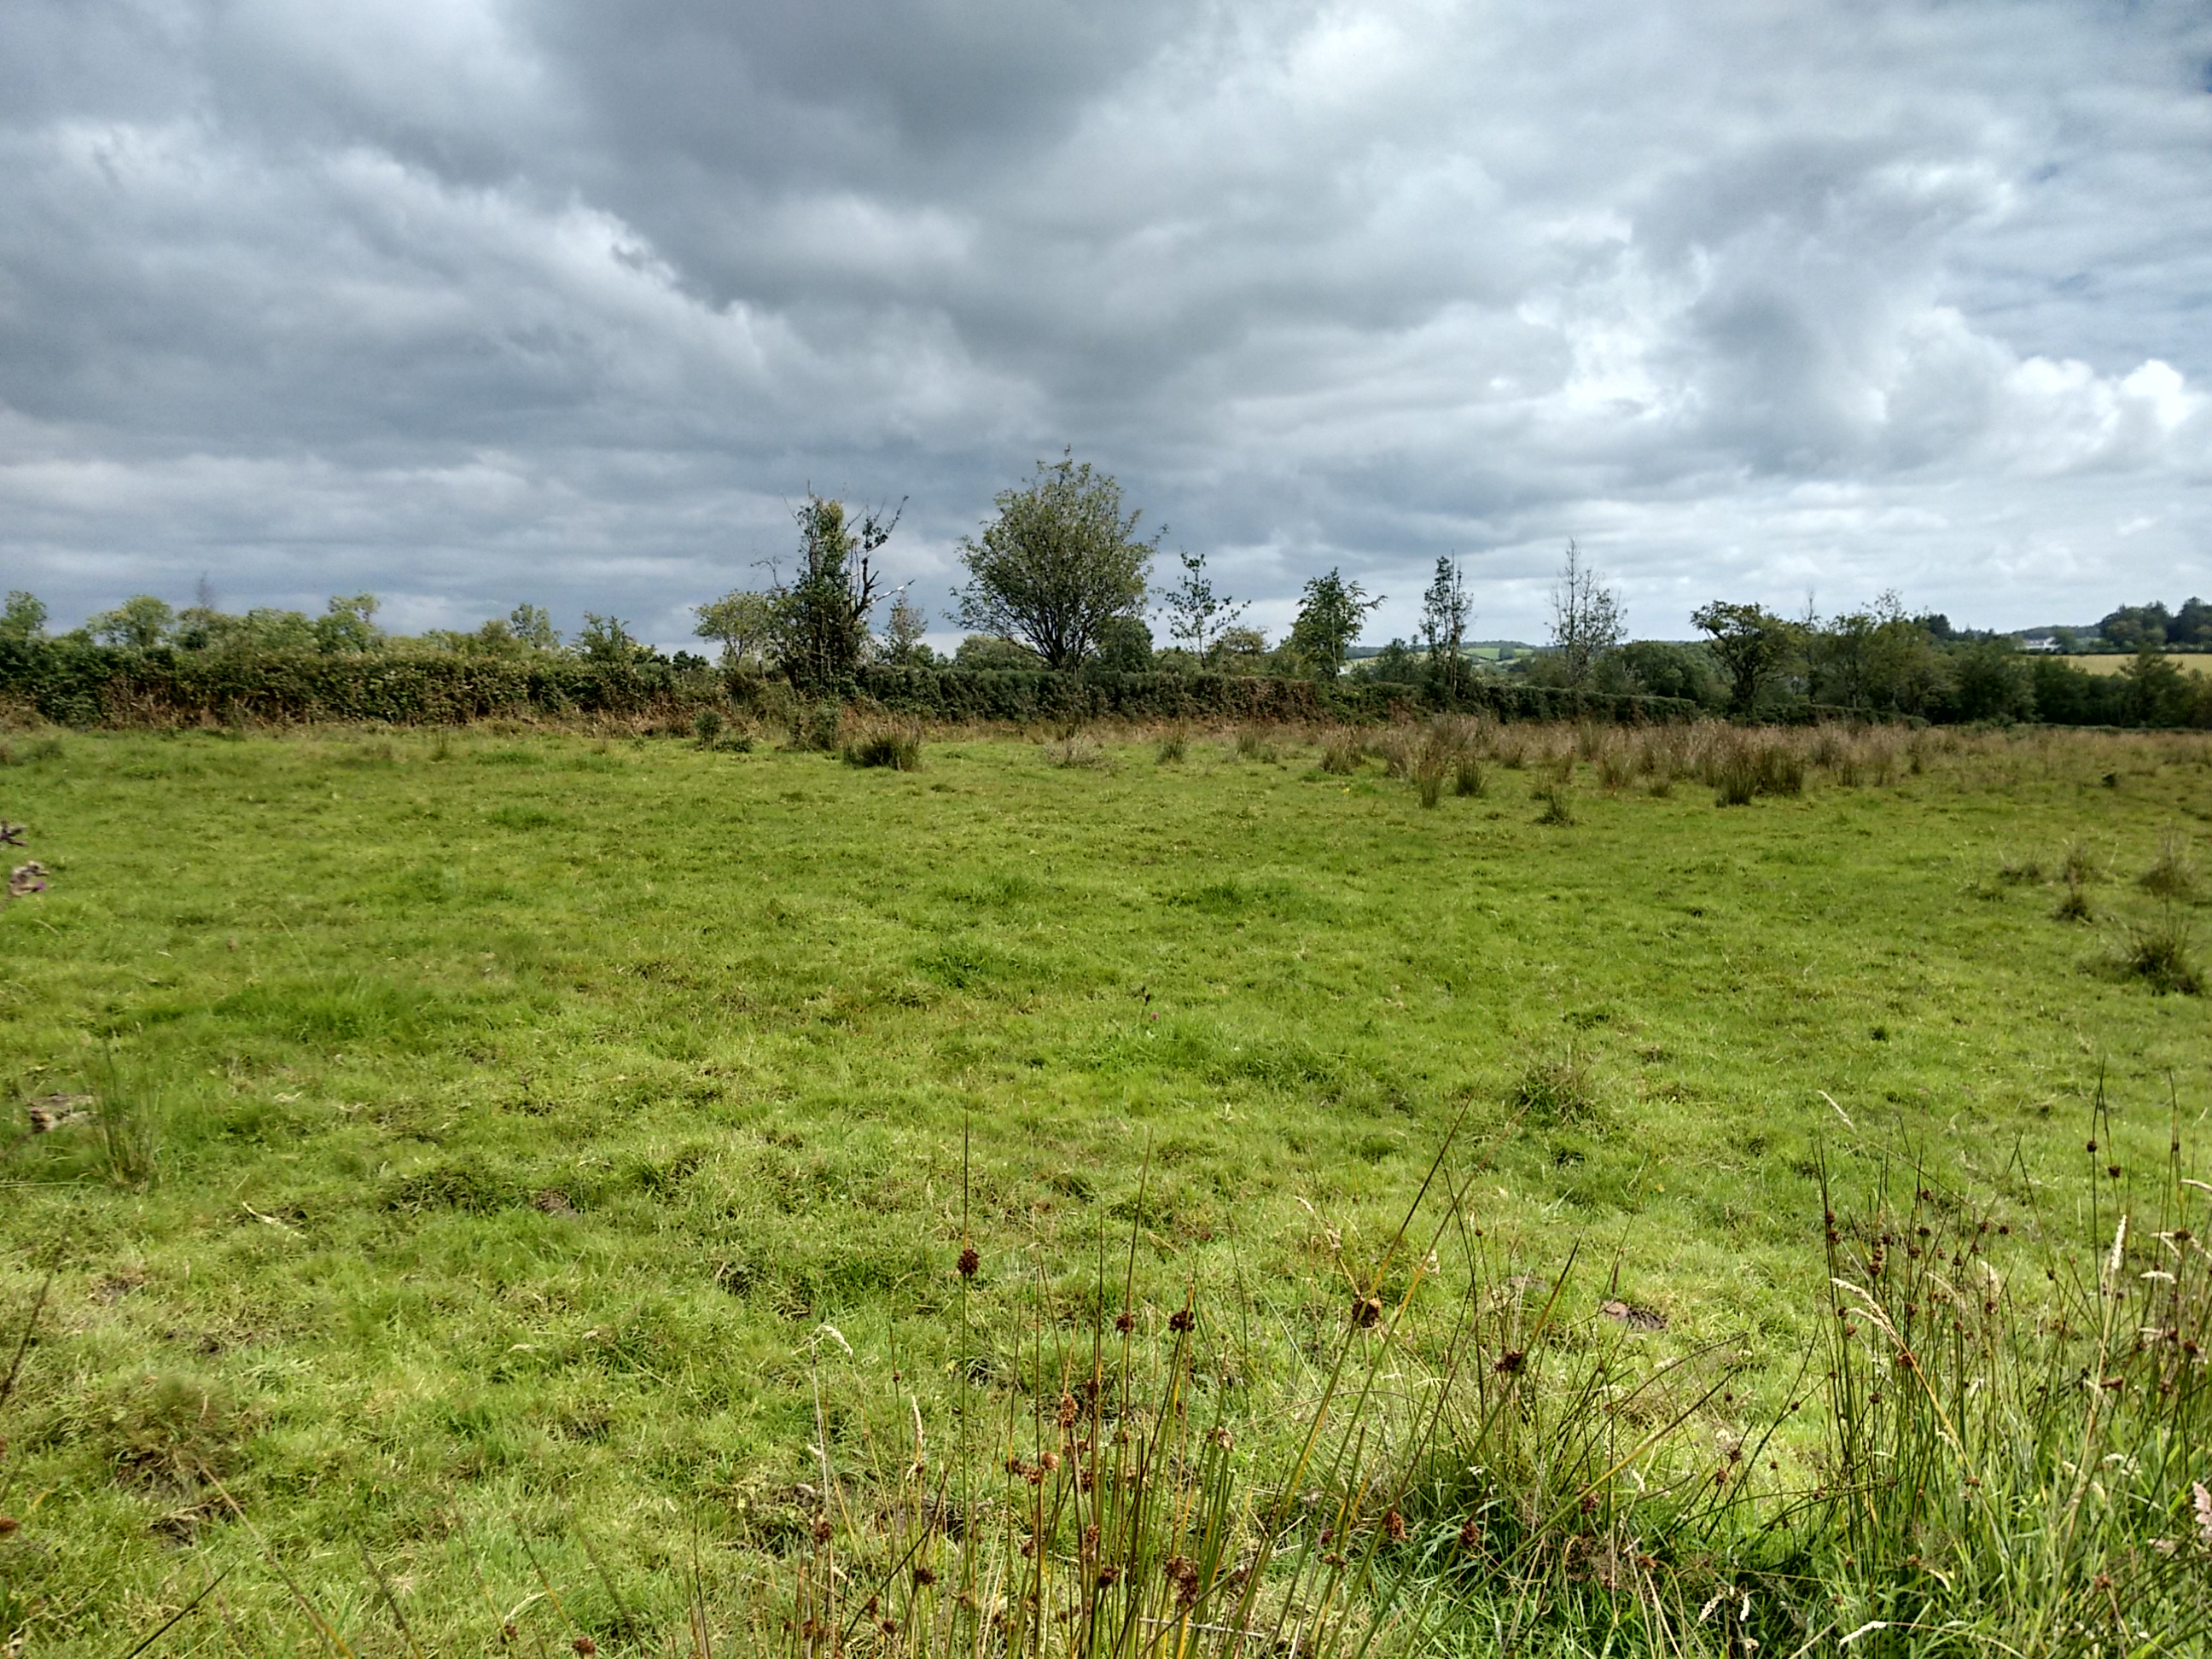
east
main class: Grassland
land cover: Grassland without tree/shrub cover
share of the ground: > 75 %
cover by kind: herbaceous plants 100 %
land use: Agriculture (excluding fallow land and kitchen gardens)
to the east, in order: Grassland without tree/shrub cover; Abandoned hedges; Fences; Ditches and canals; Grassland without tree/shrub cover; Ditches and canals; Fences; Abandoned hedges; Grassland without tree/shrub cover; Abandoned hedges; Ditches and canals; Grassland without tree/shrub cover; Fences; Abandoned hedges; Artificial constructions in urban areas
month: August
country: GB
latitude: 54.4987
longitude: -6.9214
